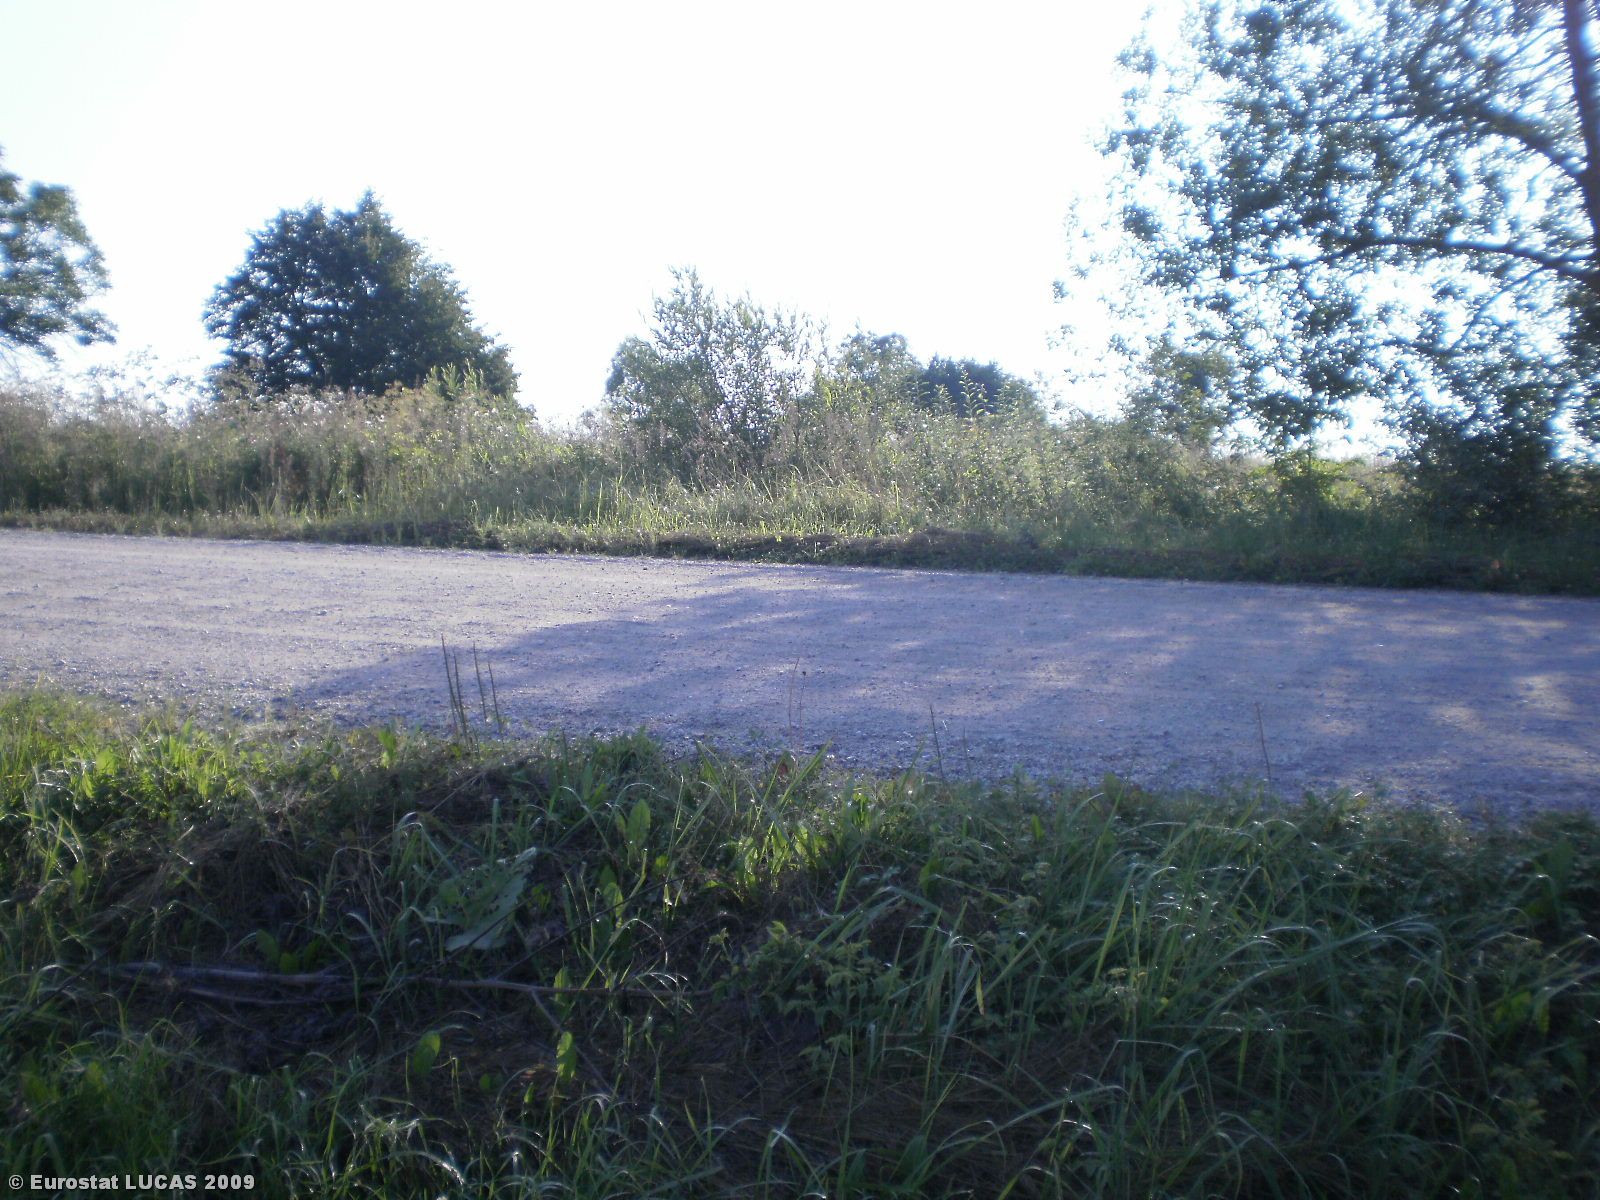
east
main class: Grassland
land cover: Grassland with sparse tree/shrub cover
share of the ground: > 75 %
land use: Residential
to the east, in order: Grassland with sparse tree/shrub cover; Paved roads, cycling and walking lanes; Grassland without tree/shrub cover; Abandoned hedges; Ditches and canals; Rape and turnip rape
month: August
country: LT
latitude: 55.5243
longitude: 24.9531
